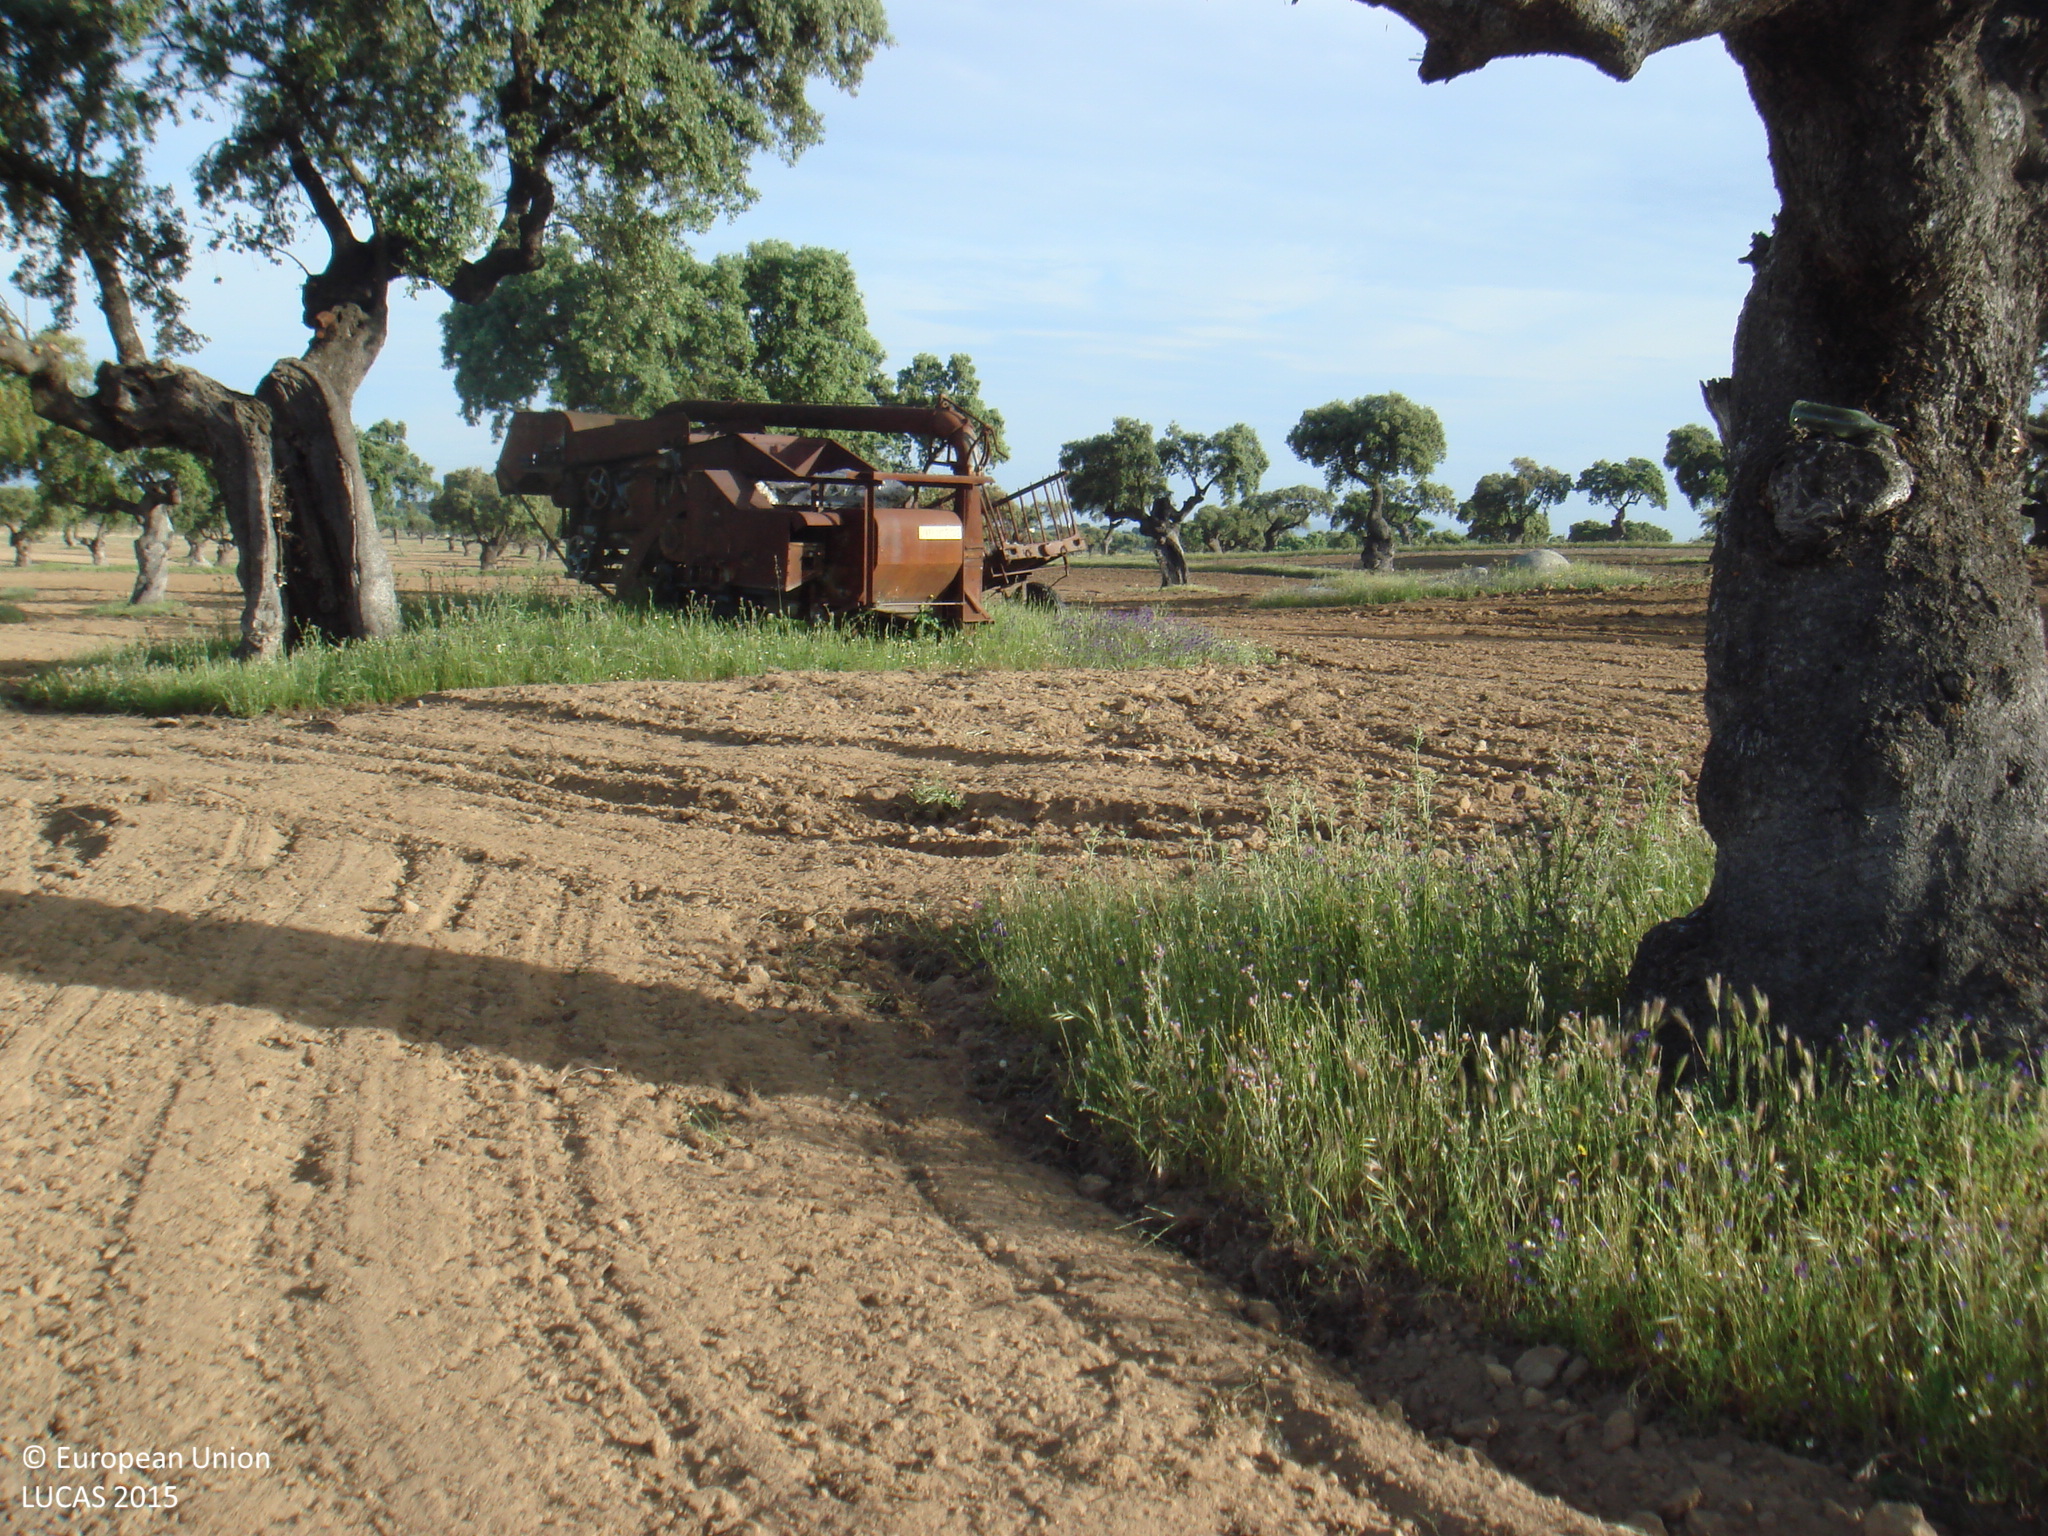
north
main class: Woodland
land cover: Broadleaved woodland
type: broadleaved evergreen forest
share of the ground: 25 - 50 %
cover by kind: herbaceous plants 60 %, broadleaved forest trees 40 %
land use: Agriculture (excluding fallow land and kitchen gardens)
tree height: > 5 m
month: May
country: ES
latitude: 38.4698
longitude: -5.0773
